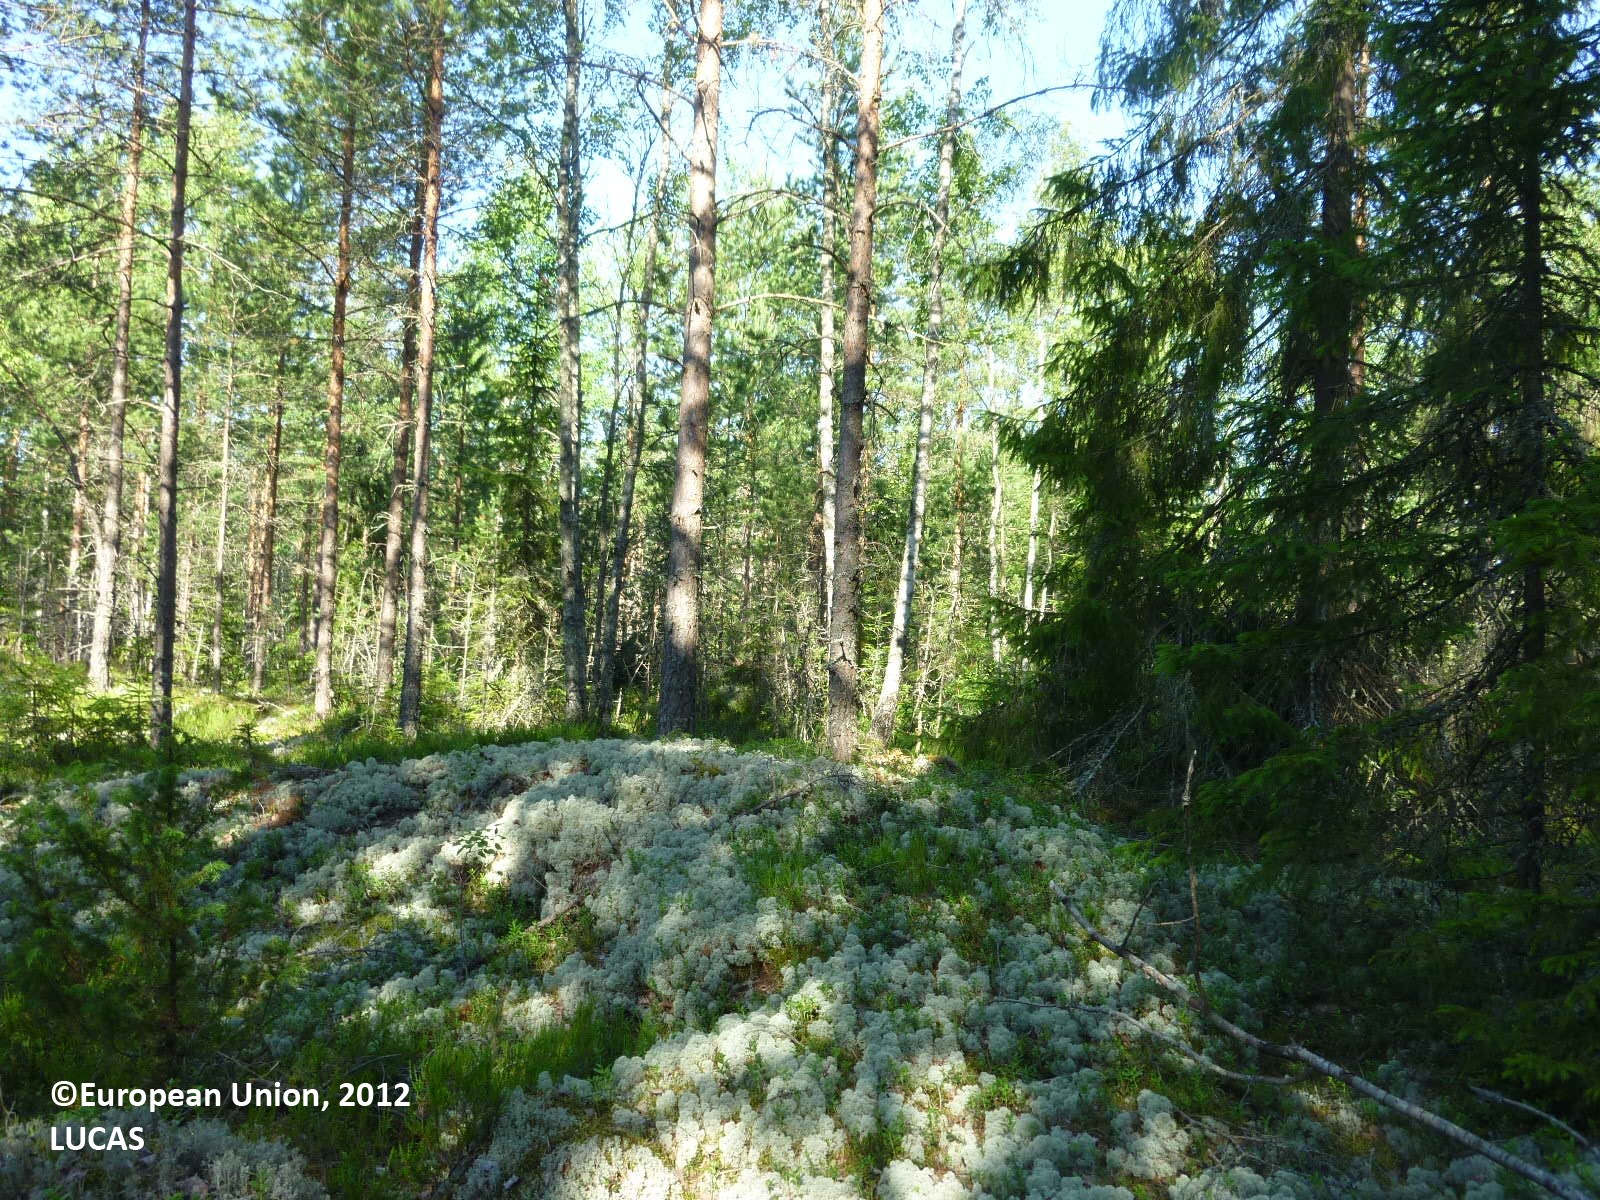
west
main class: Woodland
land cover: Pine dominated mixed woodland
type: boreal forest
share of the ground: 25 - 50 %
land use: Forestry
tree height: > 5 m
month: July
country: FI
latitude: 61.1680
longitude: 22.5773
